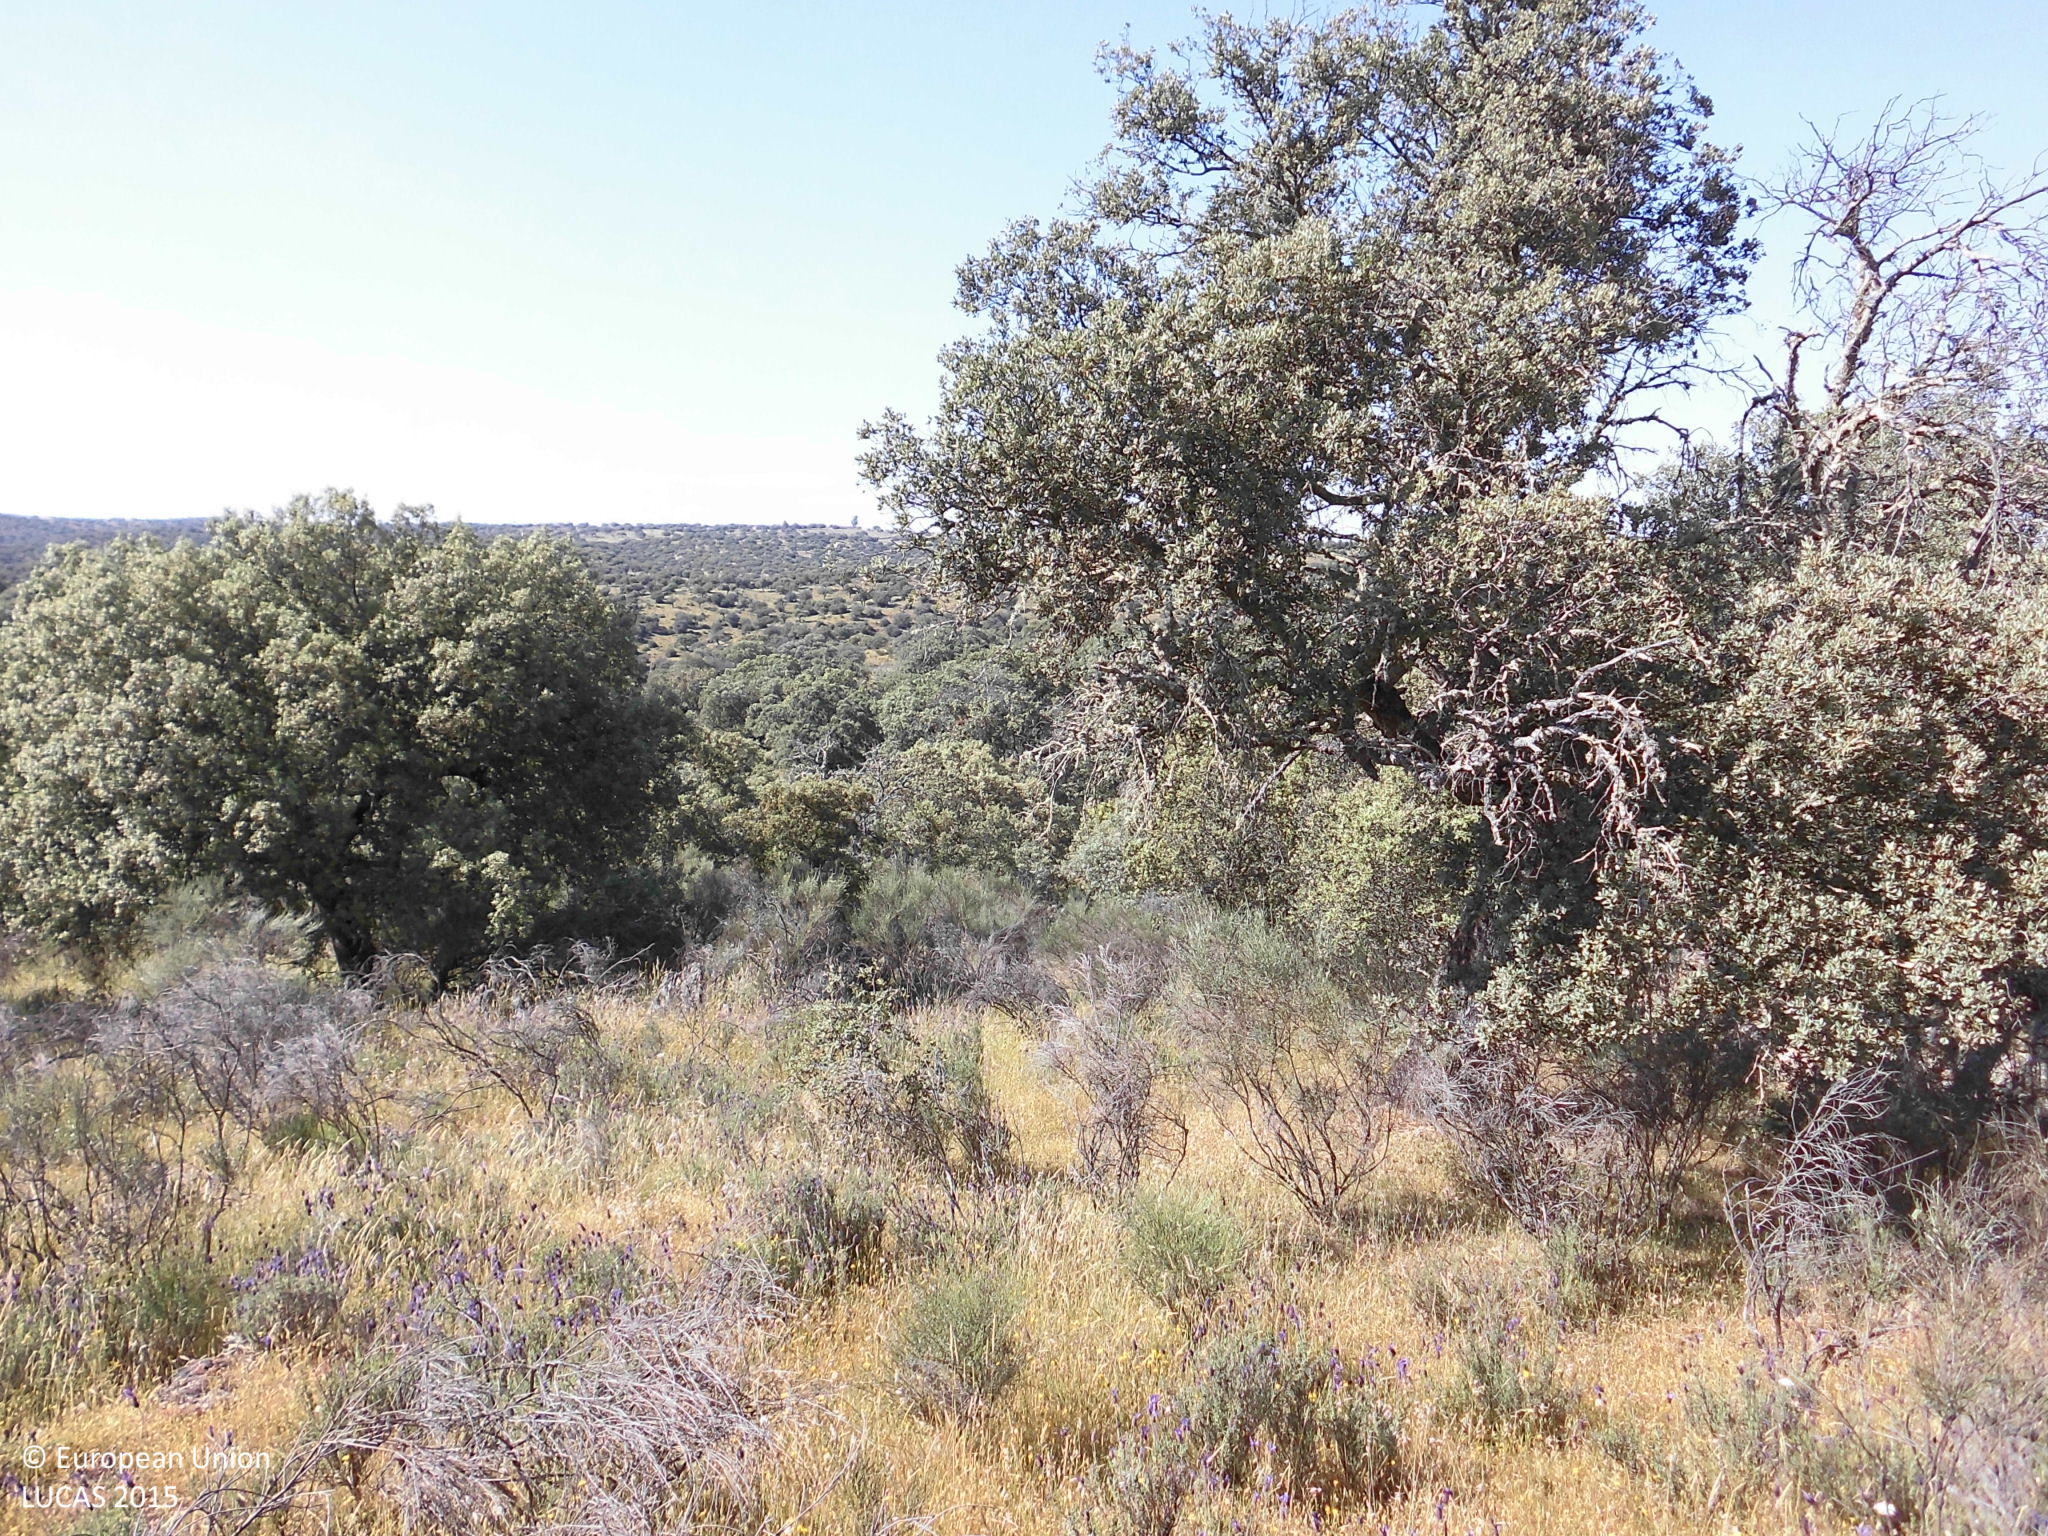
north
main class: Woodland
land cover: Broadleaved woodland
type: broadleaved evergreen forest
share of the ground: 25 - 50 %
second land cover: Shrubland without tree cover
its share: > 75 %
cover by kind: herbaceous plants 50 %, broadleaved forest trees 30 %, shrubs 20 %
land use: Forestry
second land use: Agriculture (excluding fallow land and kitchen gardens)
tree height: > 5 m
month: May
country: ES
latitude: 39.5339
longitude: -6.1078
